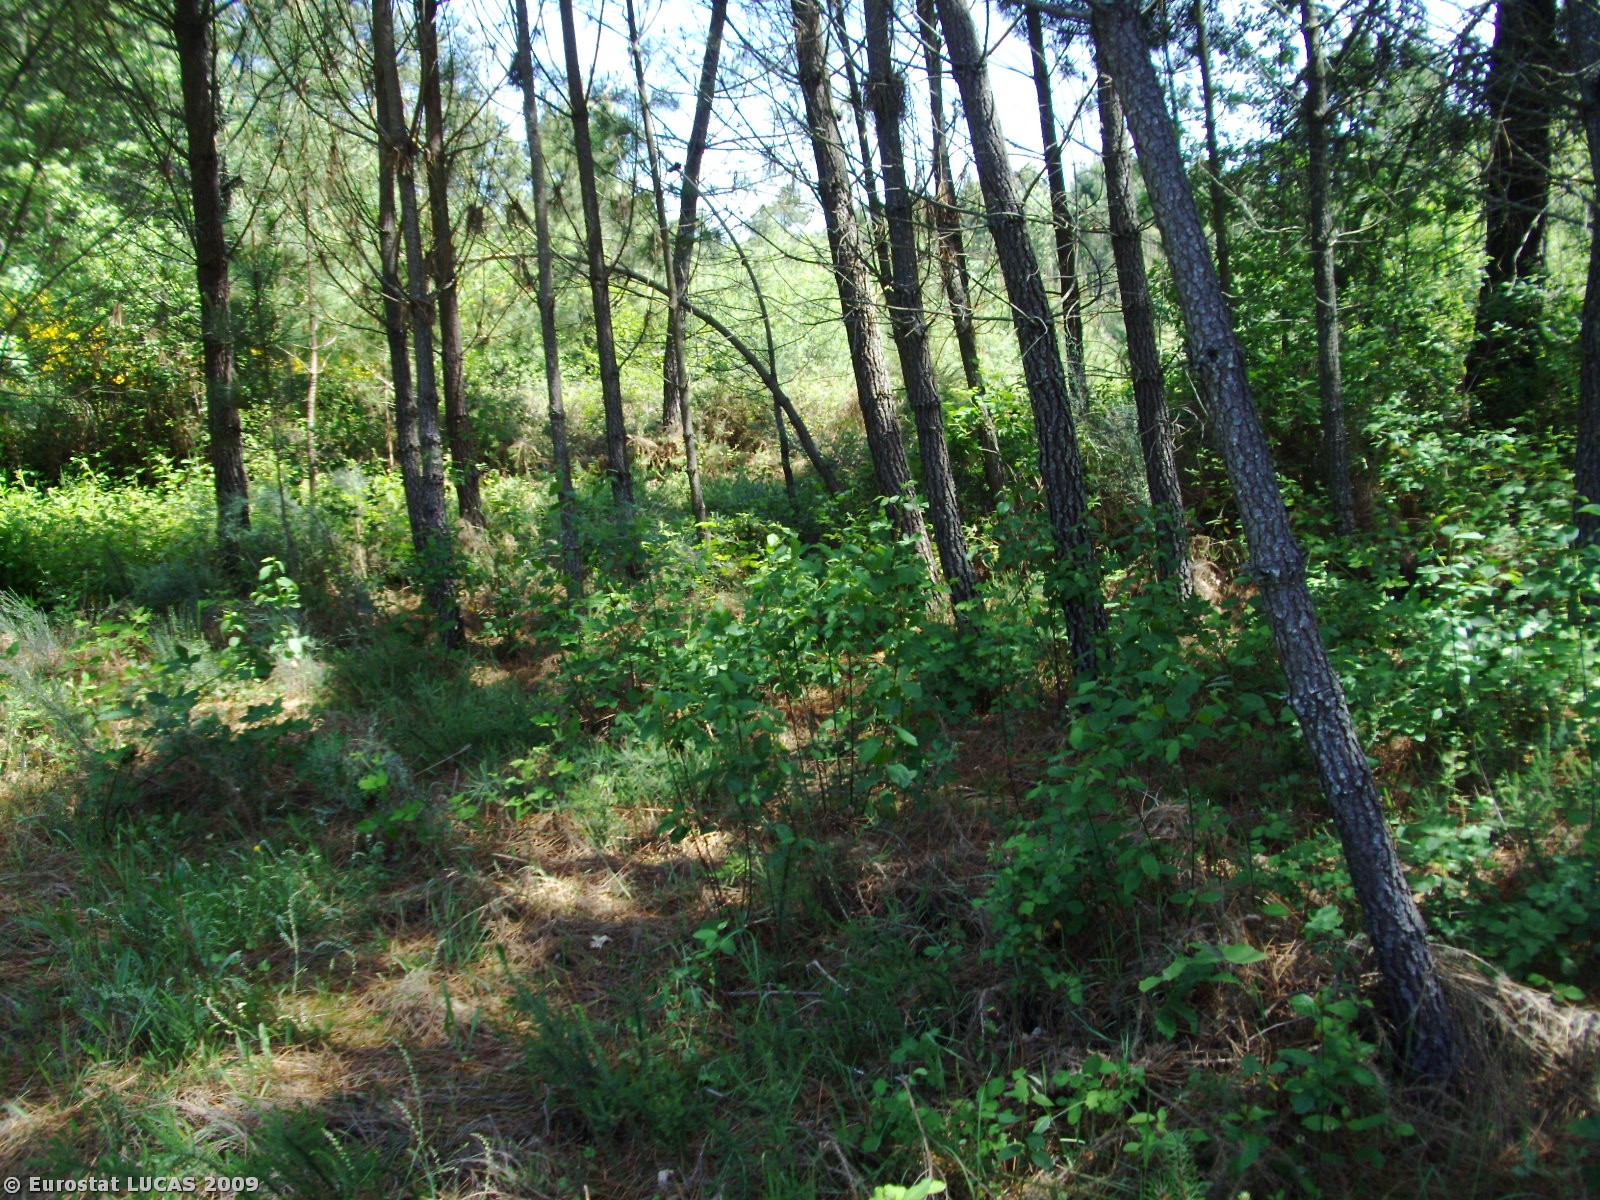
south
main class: Woodland
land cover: Coniferous woodland
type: coniferous forest of the mediterranean region
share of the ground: 50 - 75 %
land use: Forestry
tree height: > 5 m
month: May
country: PT
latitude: 40.7670
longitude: -7.4947
